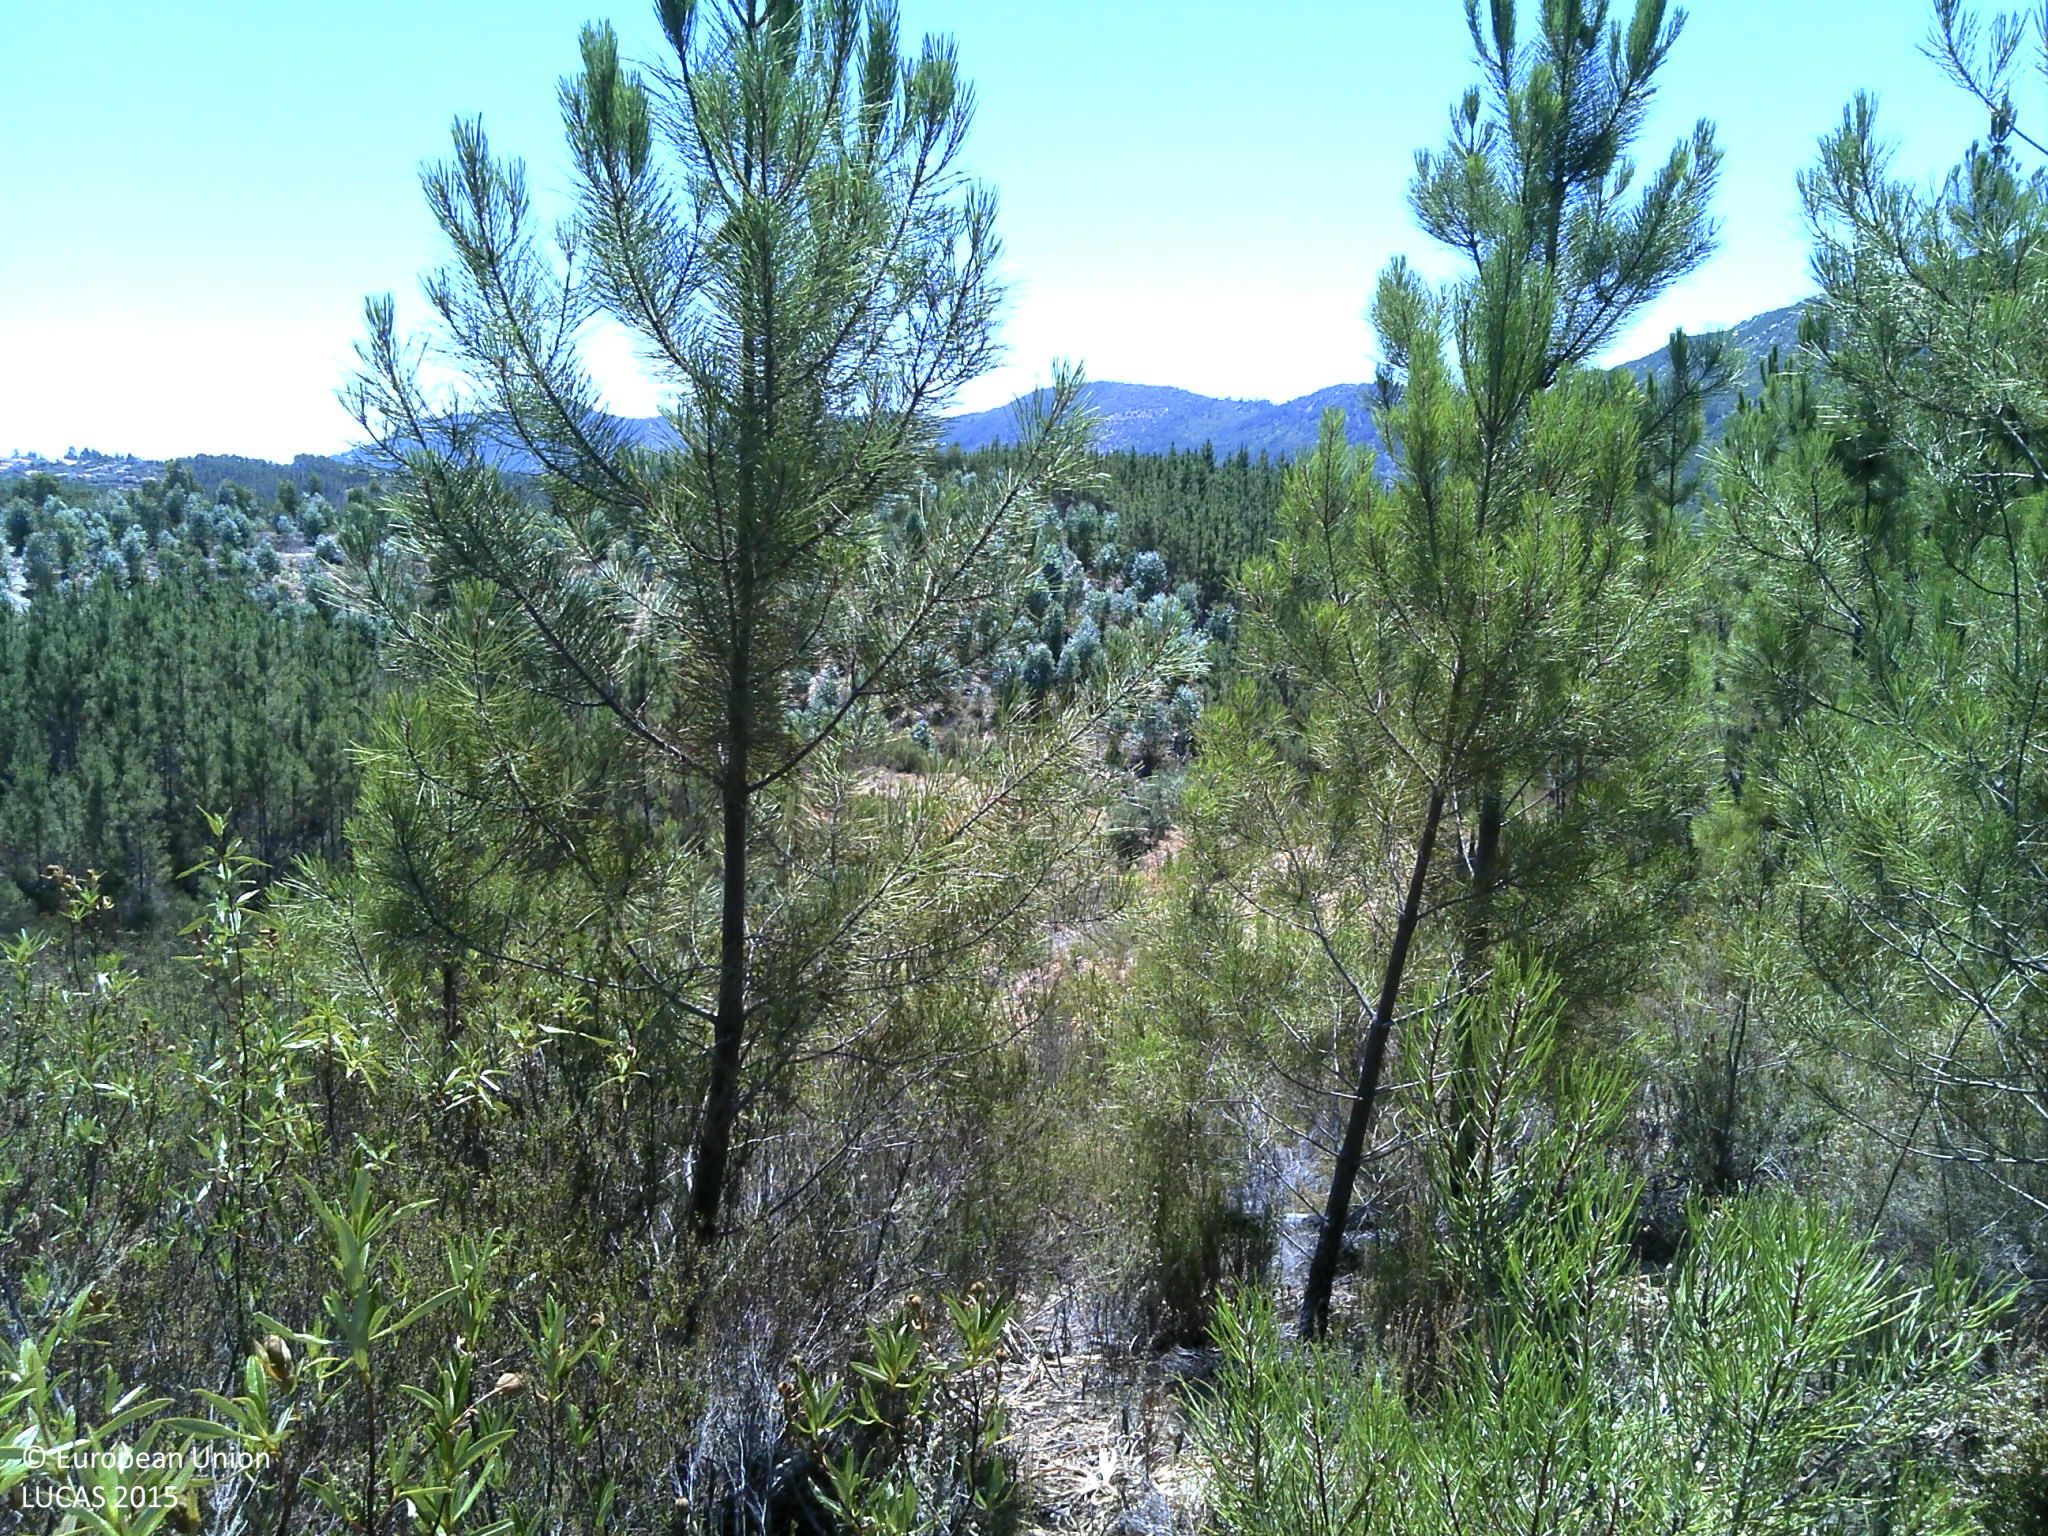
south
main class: Woodland
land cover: Pine dominated coniferous woodland
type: coniferous forest of the mediterranean region
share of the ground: 10 - 25 %
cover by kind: unconsolidated bare surface 40 %, shrubs 30 %, coniferous forest trees 20 %, consolidated bare surface 10 %
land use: Forestry
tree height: < 5 m
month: July
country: PT
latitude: 39.7623
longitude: -7.7419
